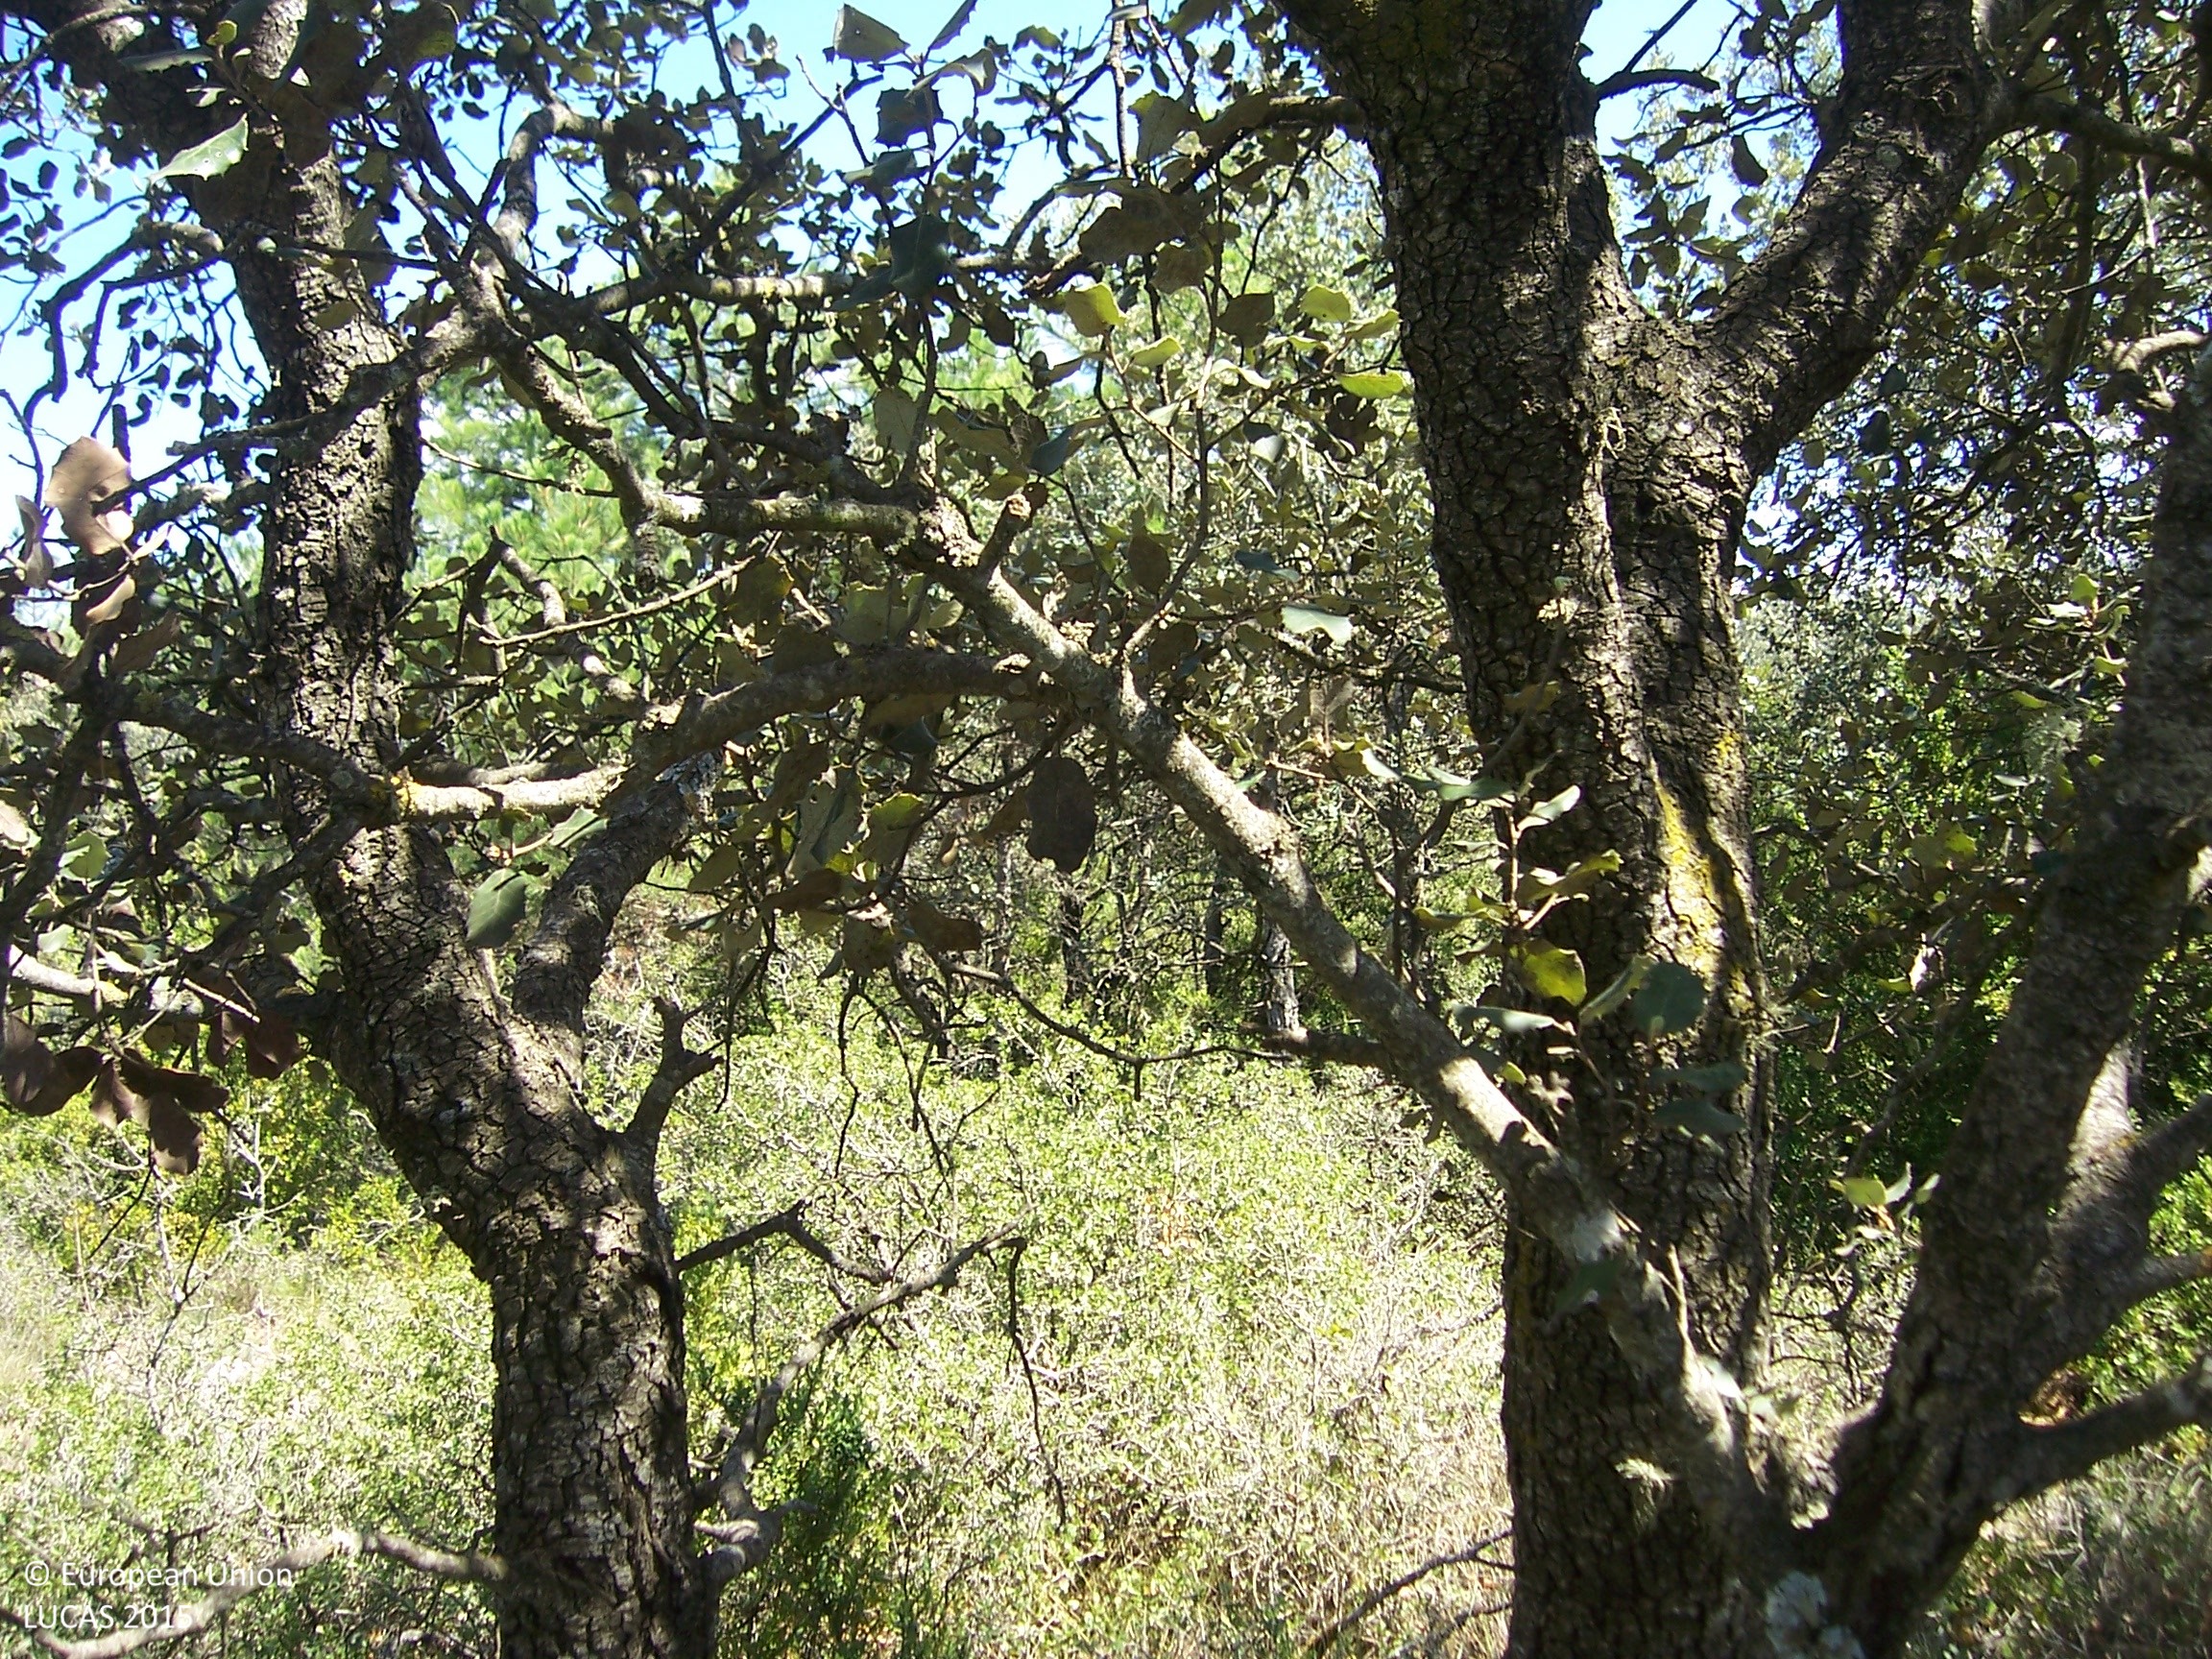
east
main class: Woodland
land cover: Pine dominated mixed woodland
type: coniferous forest of the mediterranean region
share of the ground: > 75 %
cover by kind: coniferous forest trees 40 %, broadleaved forest trees 30 %, shrubs 20 %, herbaceous plants 10 %
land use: Semi-natural and natural areas not in use
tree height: > 5 m
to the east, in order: Pine dominated mixed woodland; Tracks; Pine dominated mixed woodland
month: August
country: ES
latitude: 41.9580
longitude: 0.5621
